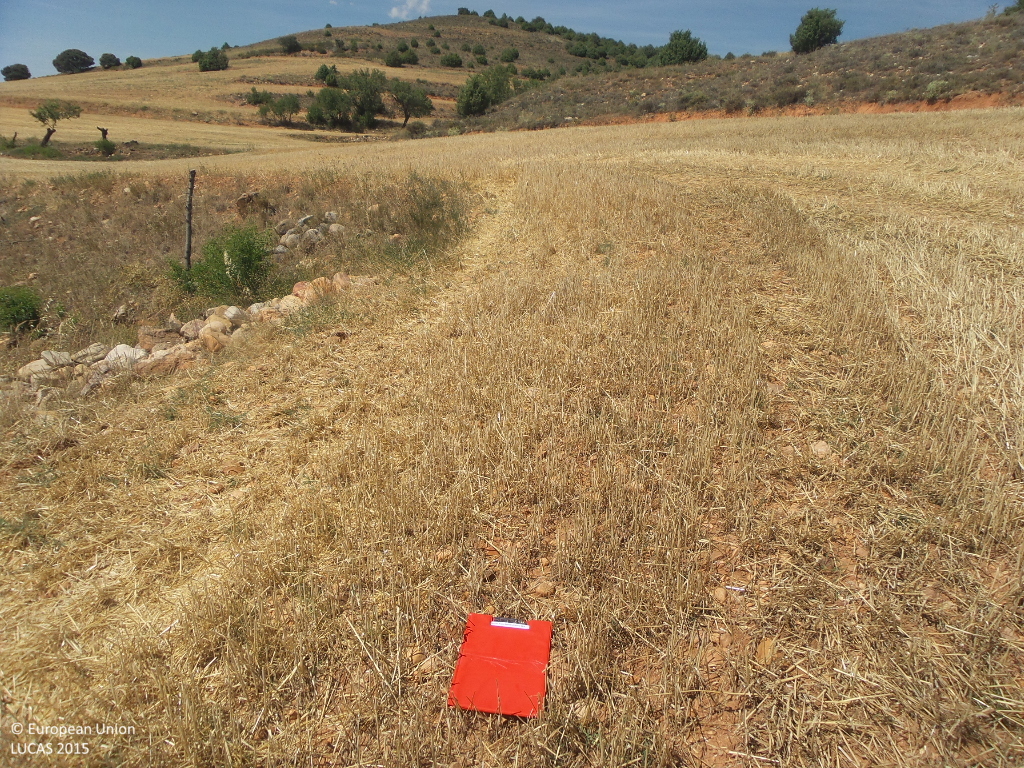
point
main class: Cropland
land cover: Common wheat
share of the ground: < 10 %
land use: Agriculture (excluding fallow land and kitchen gardens)
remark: Harvested field
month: July
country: ES
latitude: 41.2208
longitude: -1.8950
